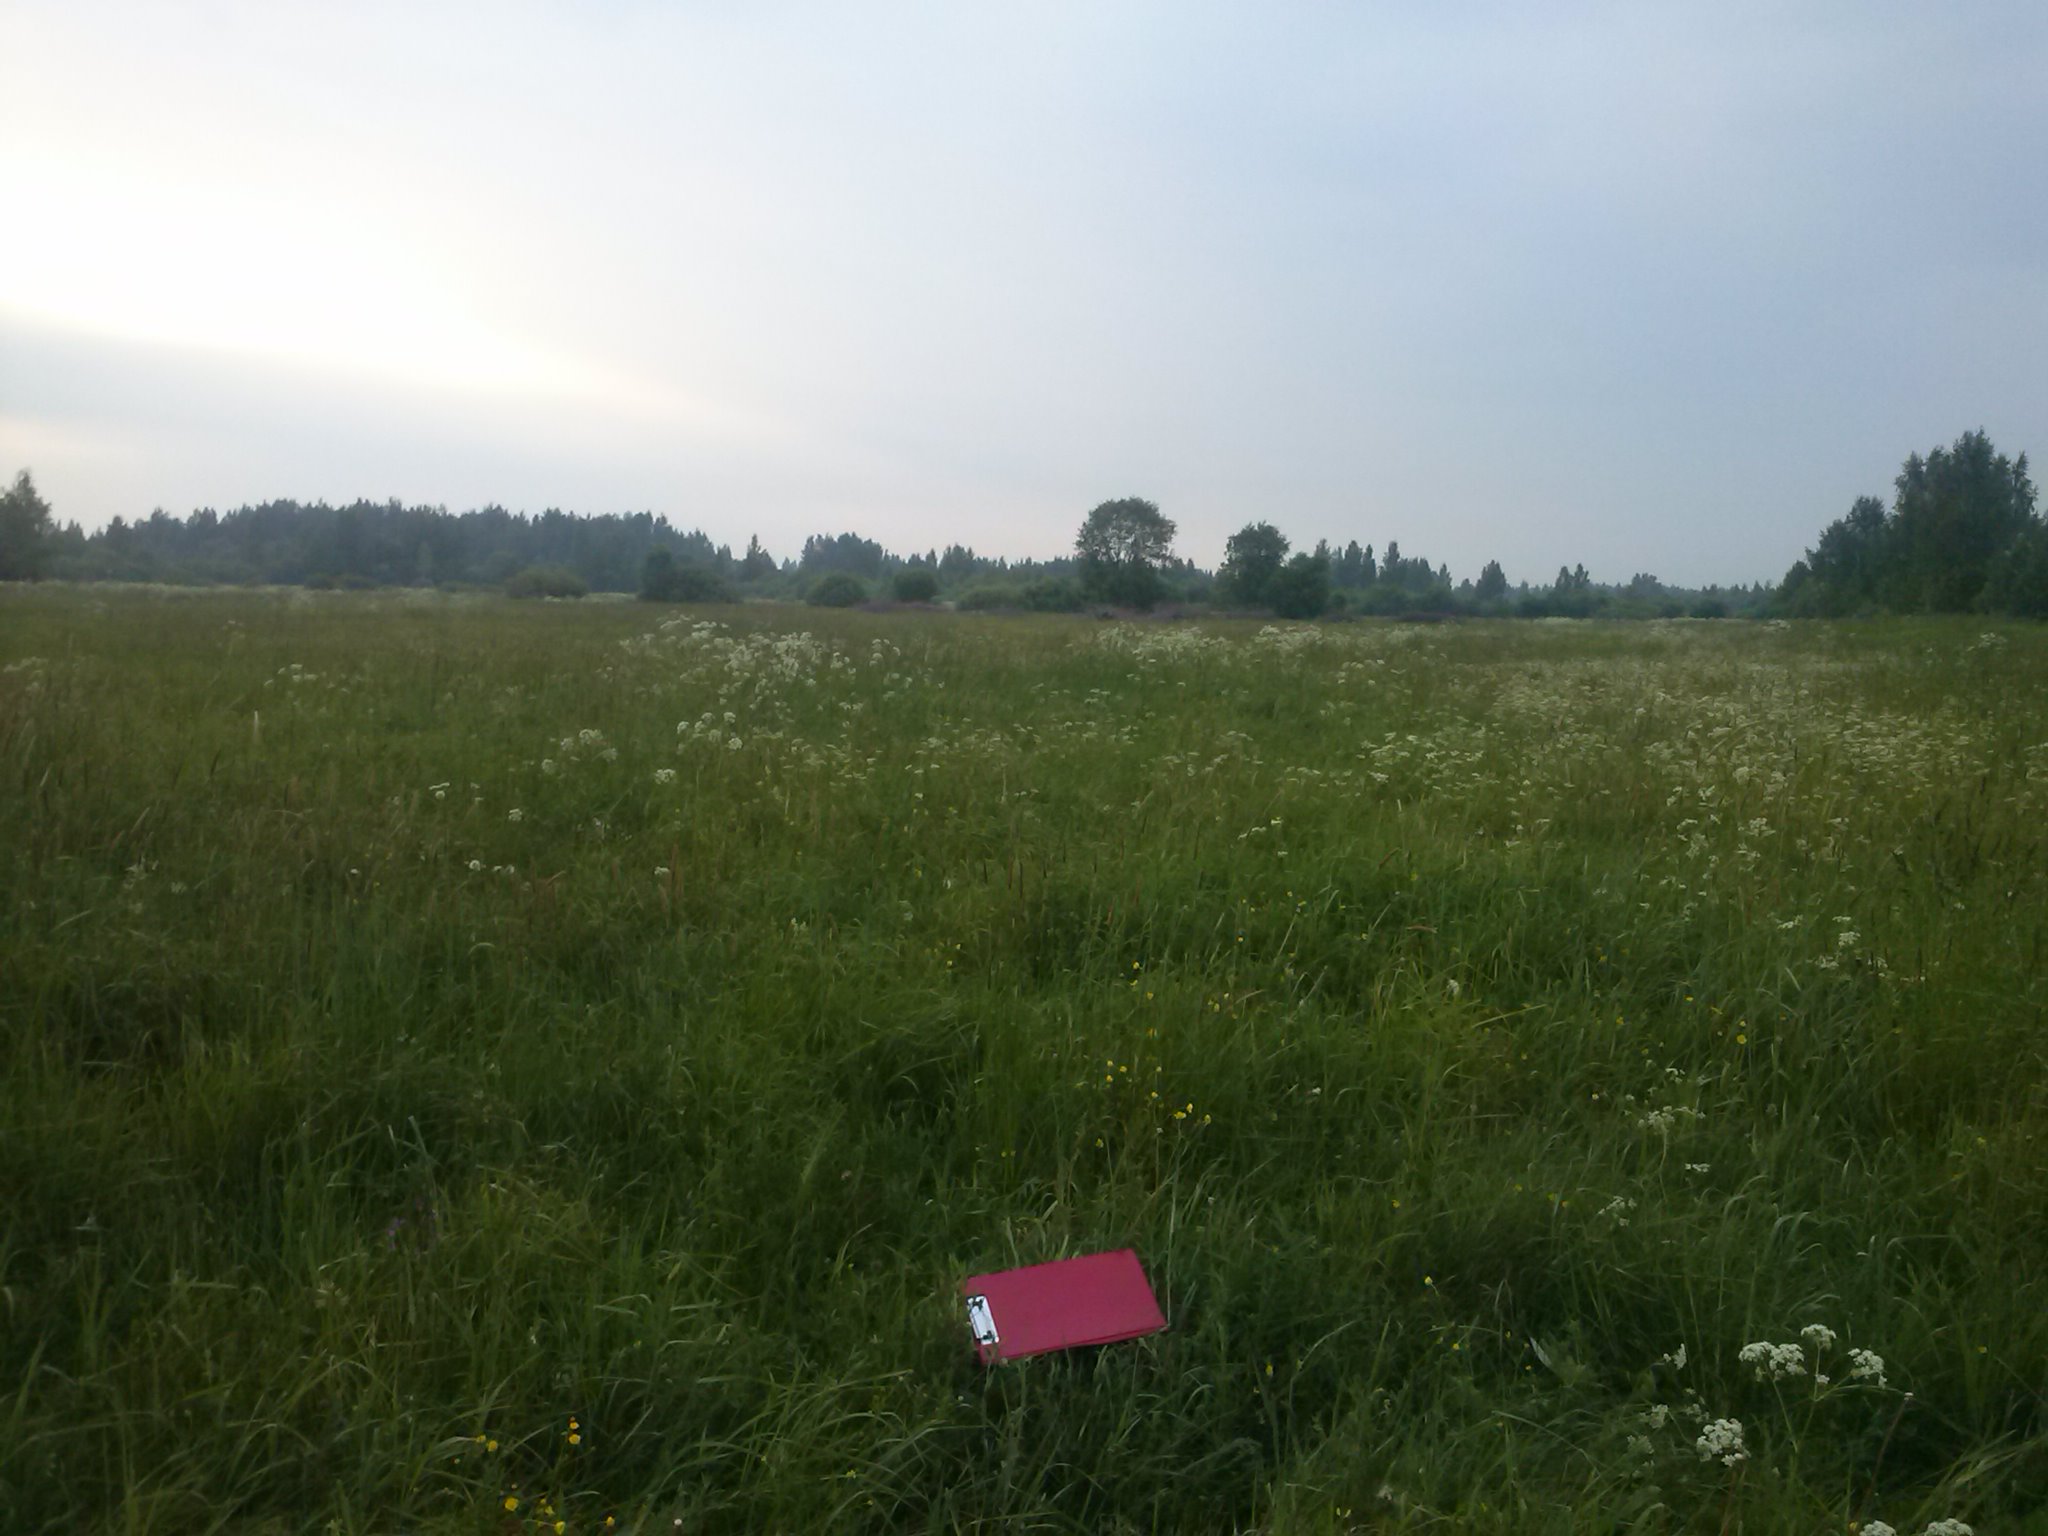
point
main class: Grassland
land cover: Grassland without tree/shrub cover
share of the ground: > 75 %
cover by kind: herbaceous plants 100 %
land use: Agriculture (excluding fallow land and kitchen gardens)
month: June
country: LV
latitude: 56.9297
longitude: 27.0714
